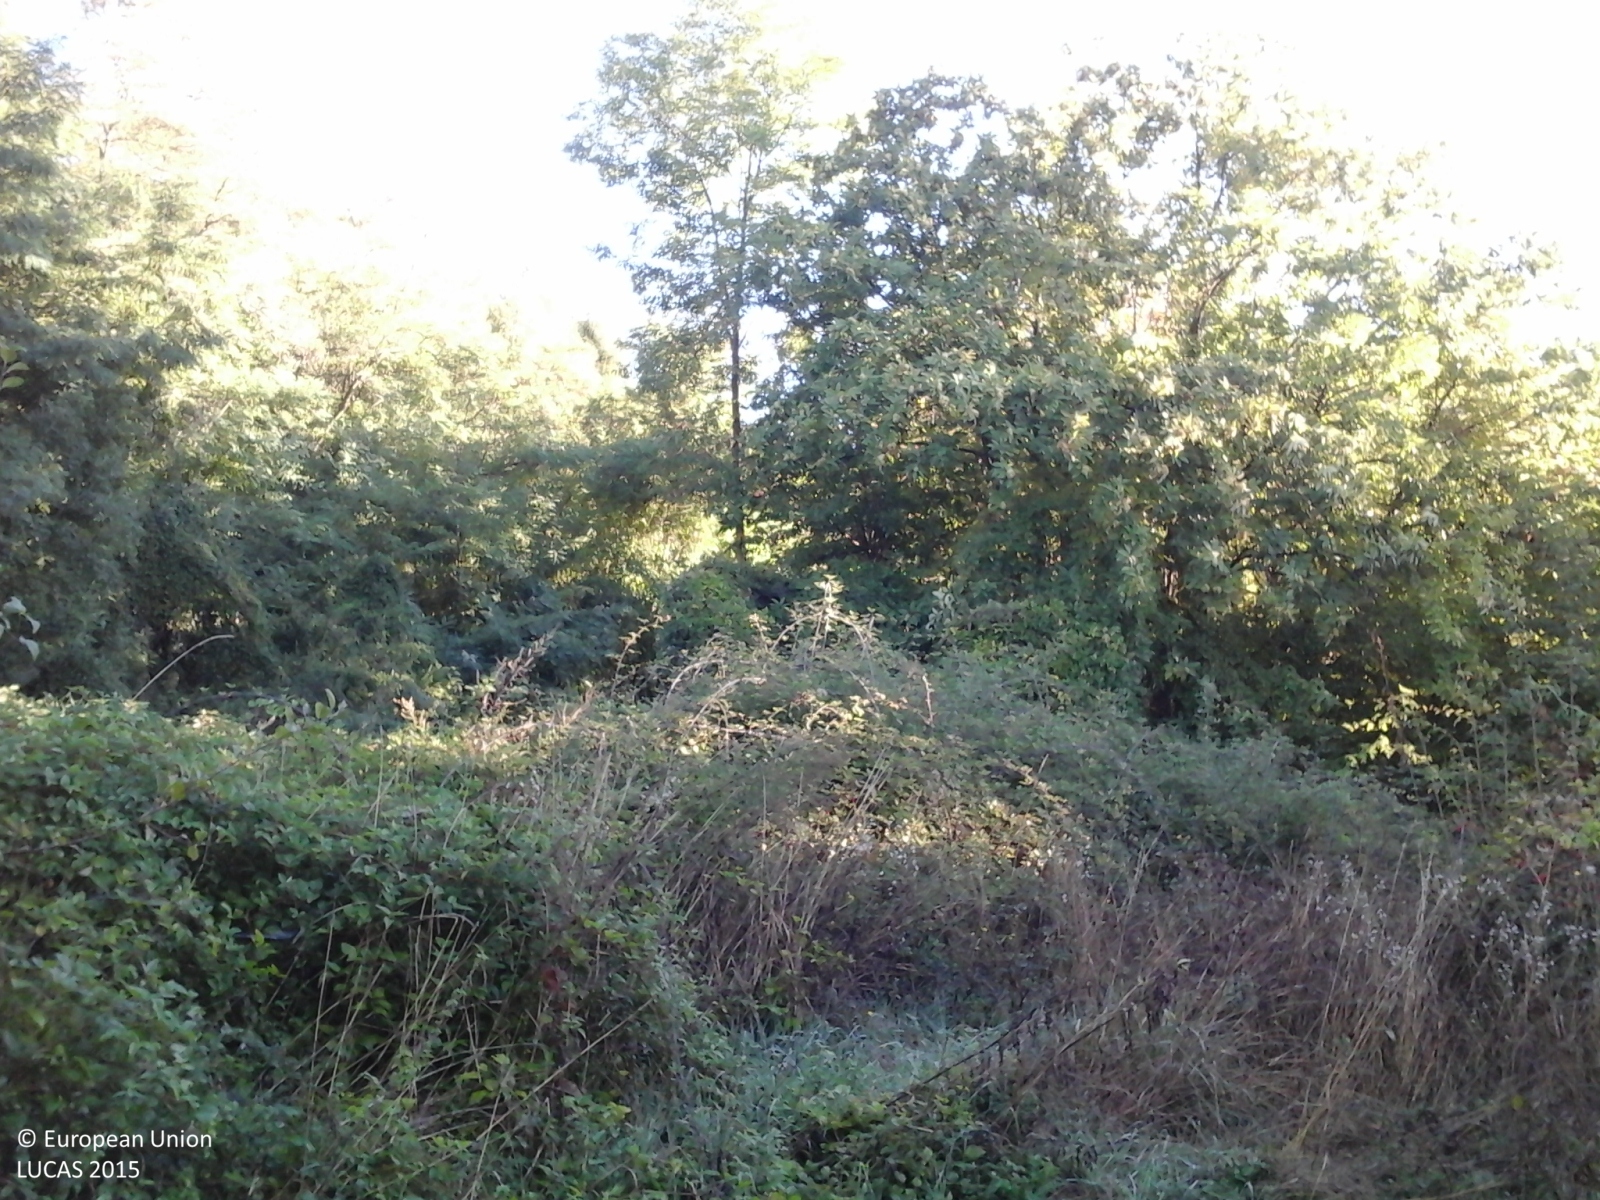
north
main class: Woodland
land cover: Broadleaved woodland
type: thermophilous deciduous forest
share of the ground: > 75 %
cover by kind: broadleaved forest trees 70 %, shrubs 15 %, herbaceous plants 10 %, coniferous forest trees 5 %
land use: Forestry
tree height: > 5 m
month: October
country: IT
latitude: 44.0756
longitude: 7.8448
